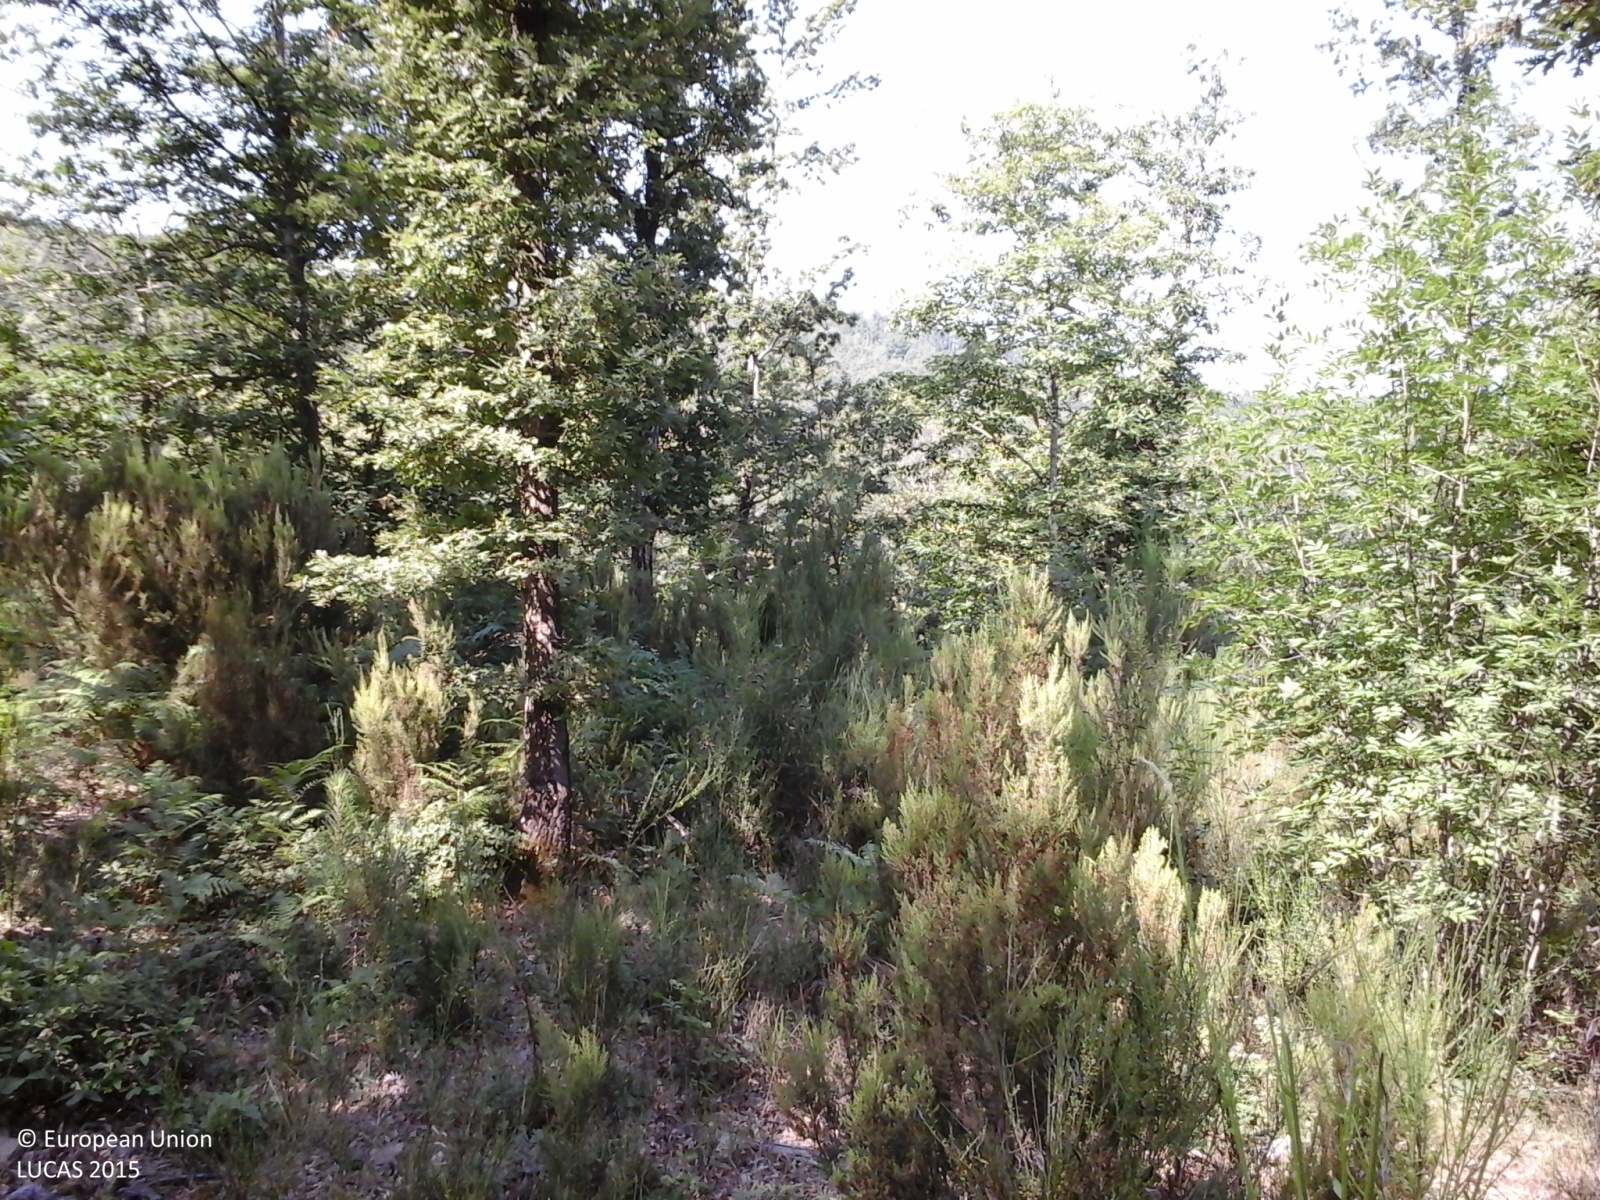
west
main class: Woodland
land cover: Broadleaved woodland
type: thermophilous deciduous forest
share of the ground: 50 - 75 %
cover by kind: shrubs 50 %, broadleaved forest trees 40 %, herbaceous plants 10 %
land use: Forestry
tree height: > 5 m
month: July
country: IT
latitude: 43.0630
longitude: 11.1385
